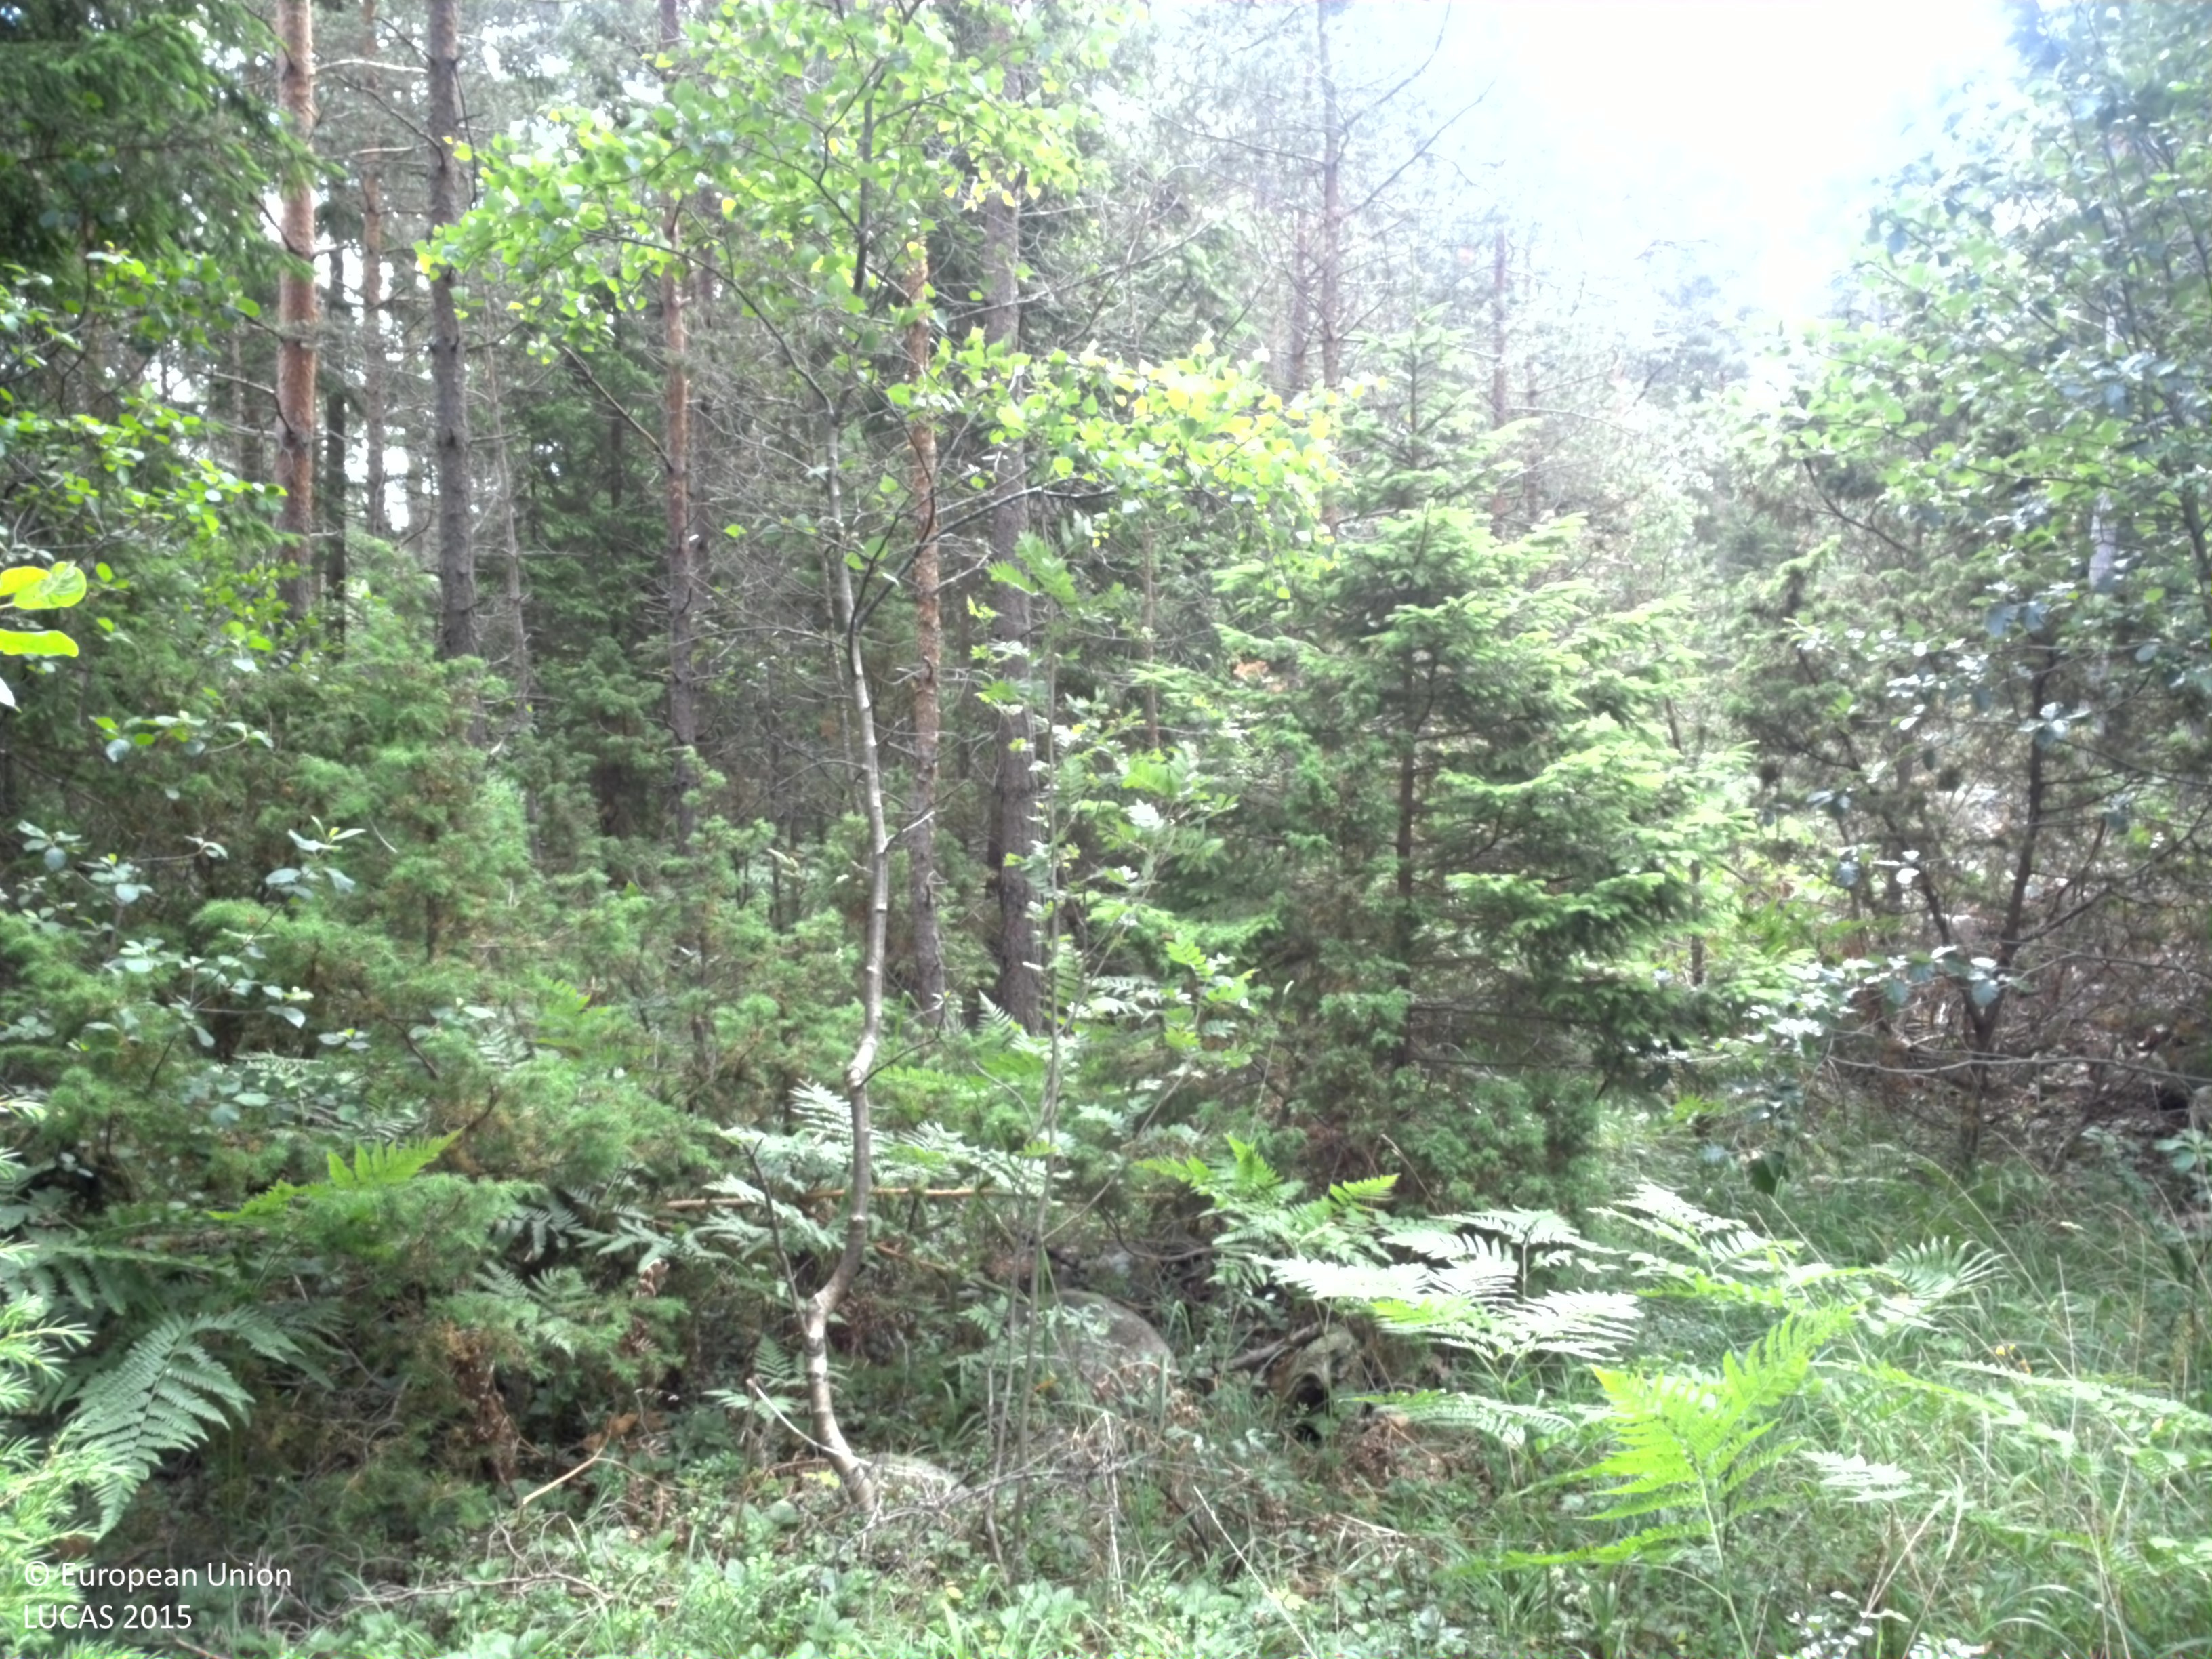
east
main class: Woodland
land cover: Pine dominated coniferous woodland
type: hemiboreal forest and nemoral coniferous forest and mixed broadleaved-coniferous forest
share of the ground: > 75 %
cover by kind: coniferous forest trees 75 %, herbaceous plants 15 %, shrubs 5 %, unconsolidated bare surface 5 %
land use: Forestry
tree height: > 5 m
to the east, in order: Pine dominated coniferous woodland; Tracks; Fences; Pine dominated coniferous woodland; Paved roads, cycling and walking lanes; Electric lines; Pine dominated coniferous woodland; Grassland without tree/shrub cover; Pine dominated coniferous woodland
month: July
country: SE
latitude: 57.5536
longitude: 18.7504
